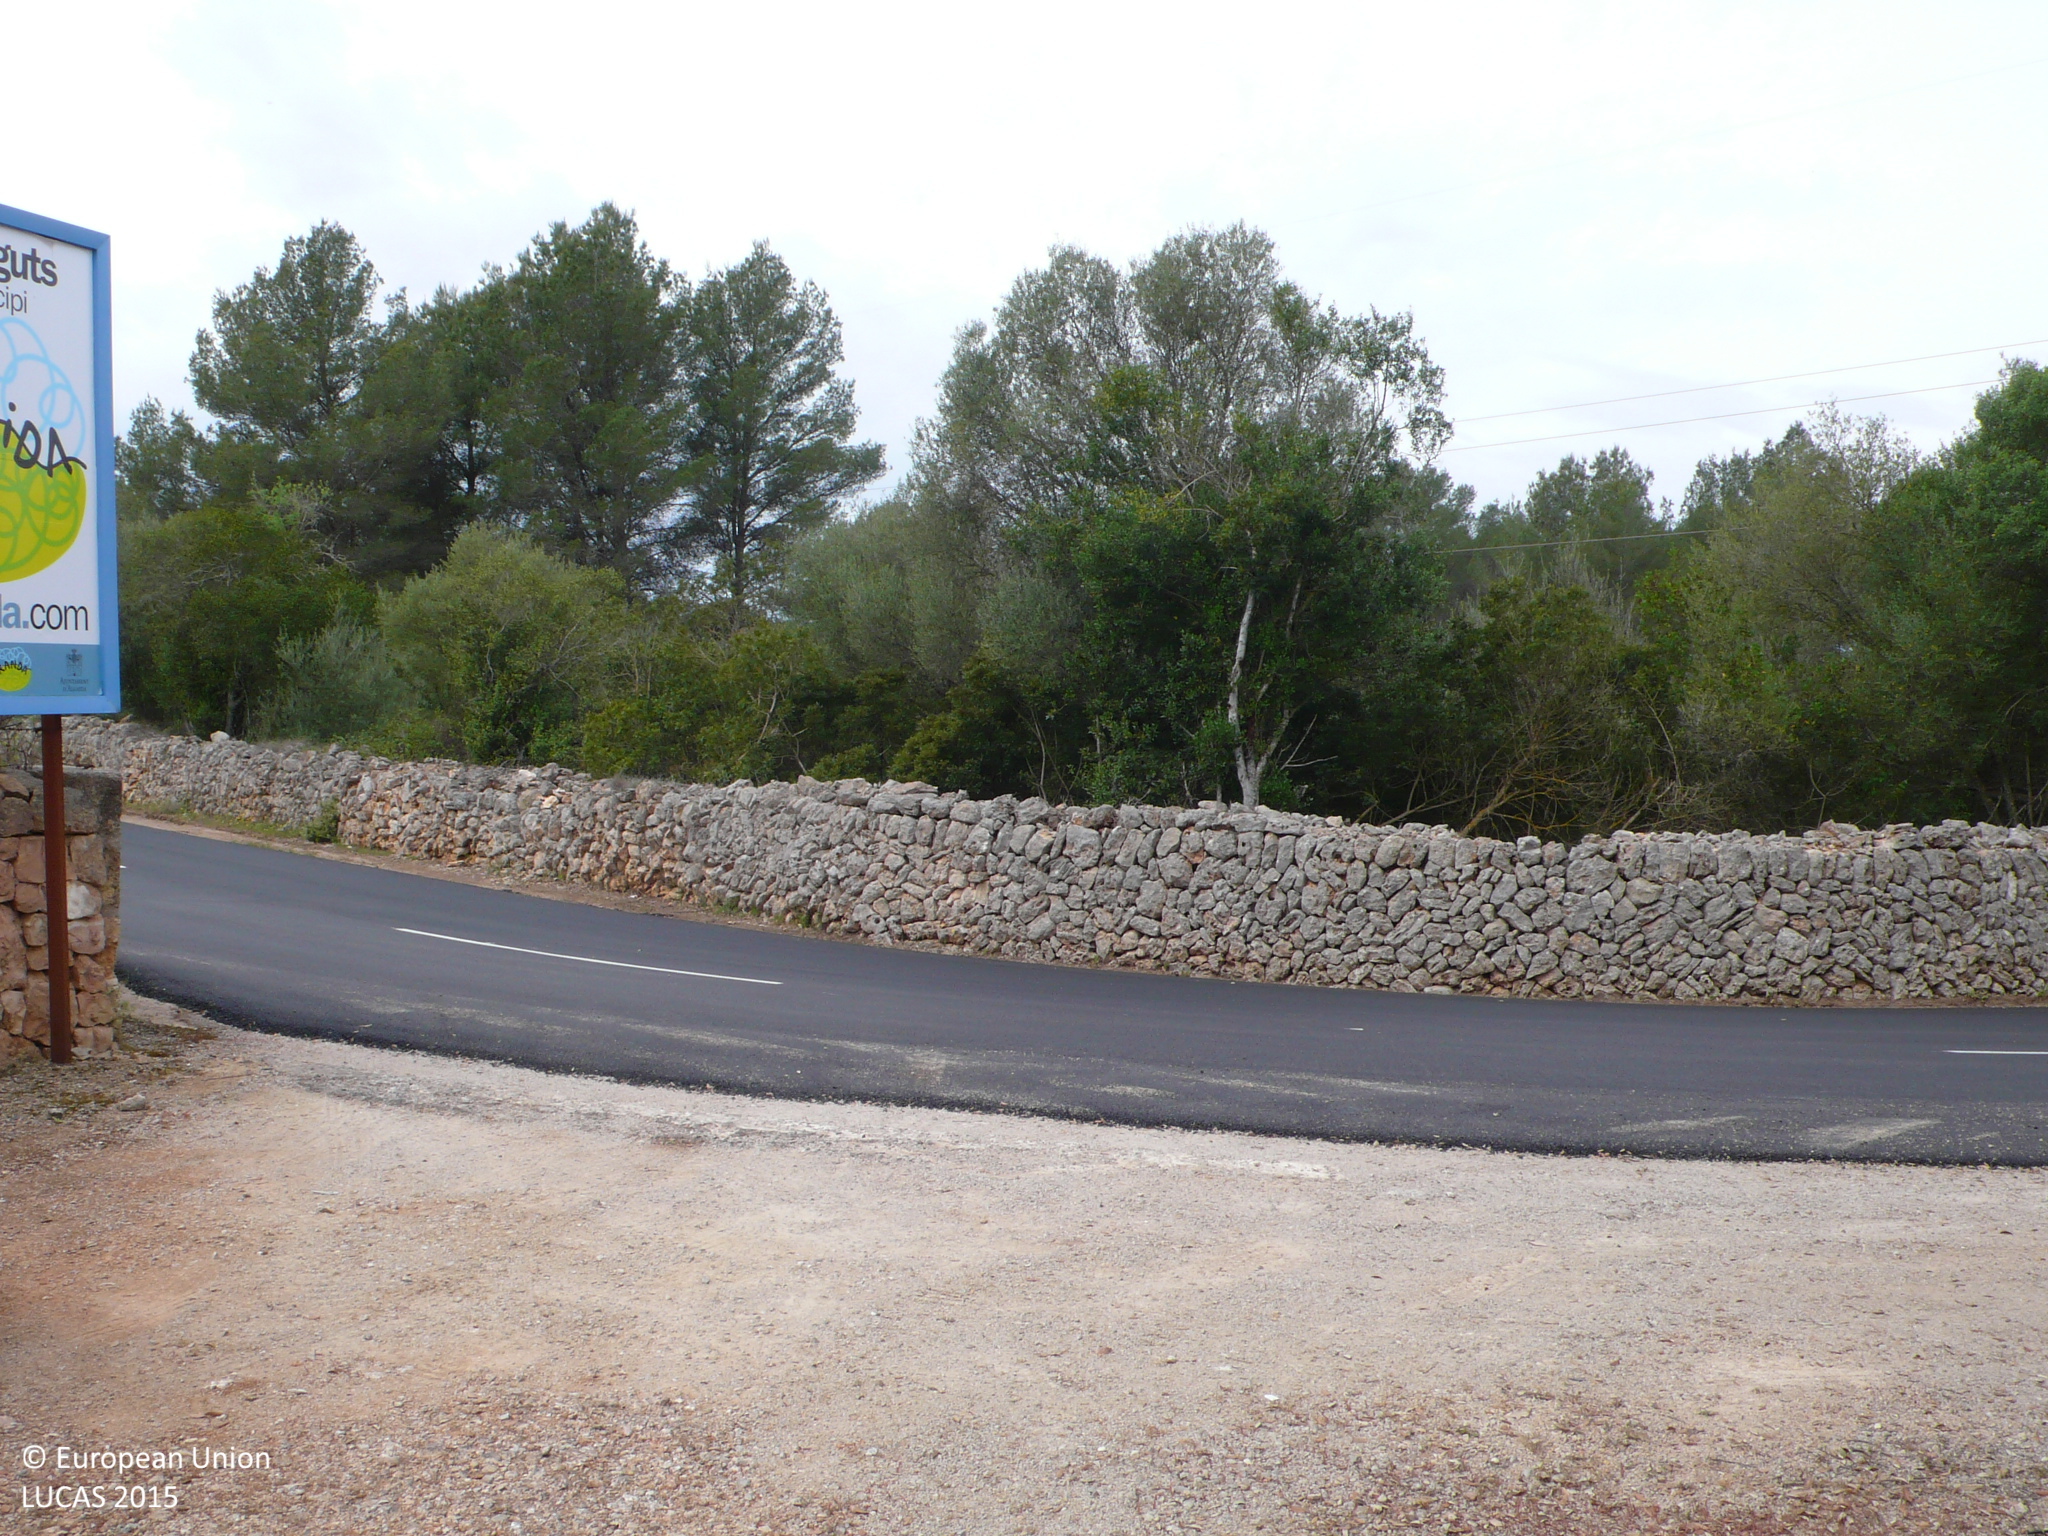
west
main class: Grassland
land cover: Spontaneously vegetated surfaces
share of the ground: > 75 %
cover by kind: herbaceous plants 100 %
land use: Fallow land
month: April
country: ES
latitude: 39.6095
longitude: 2.8903
